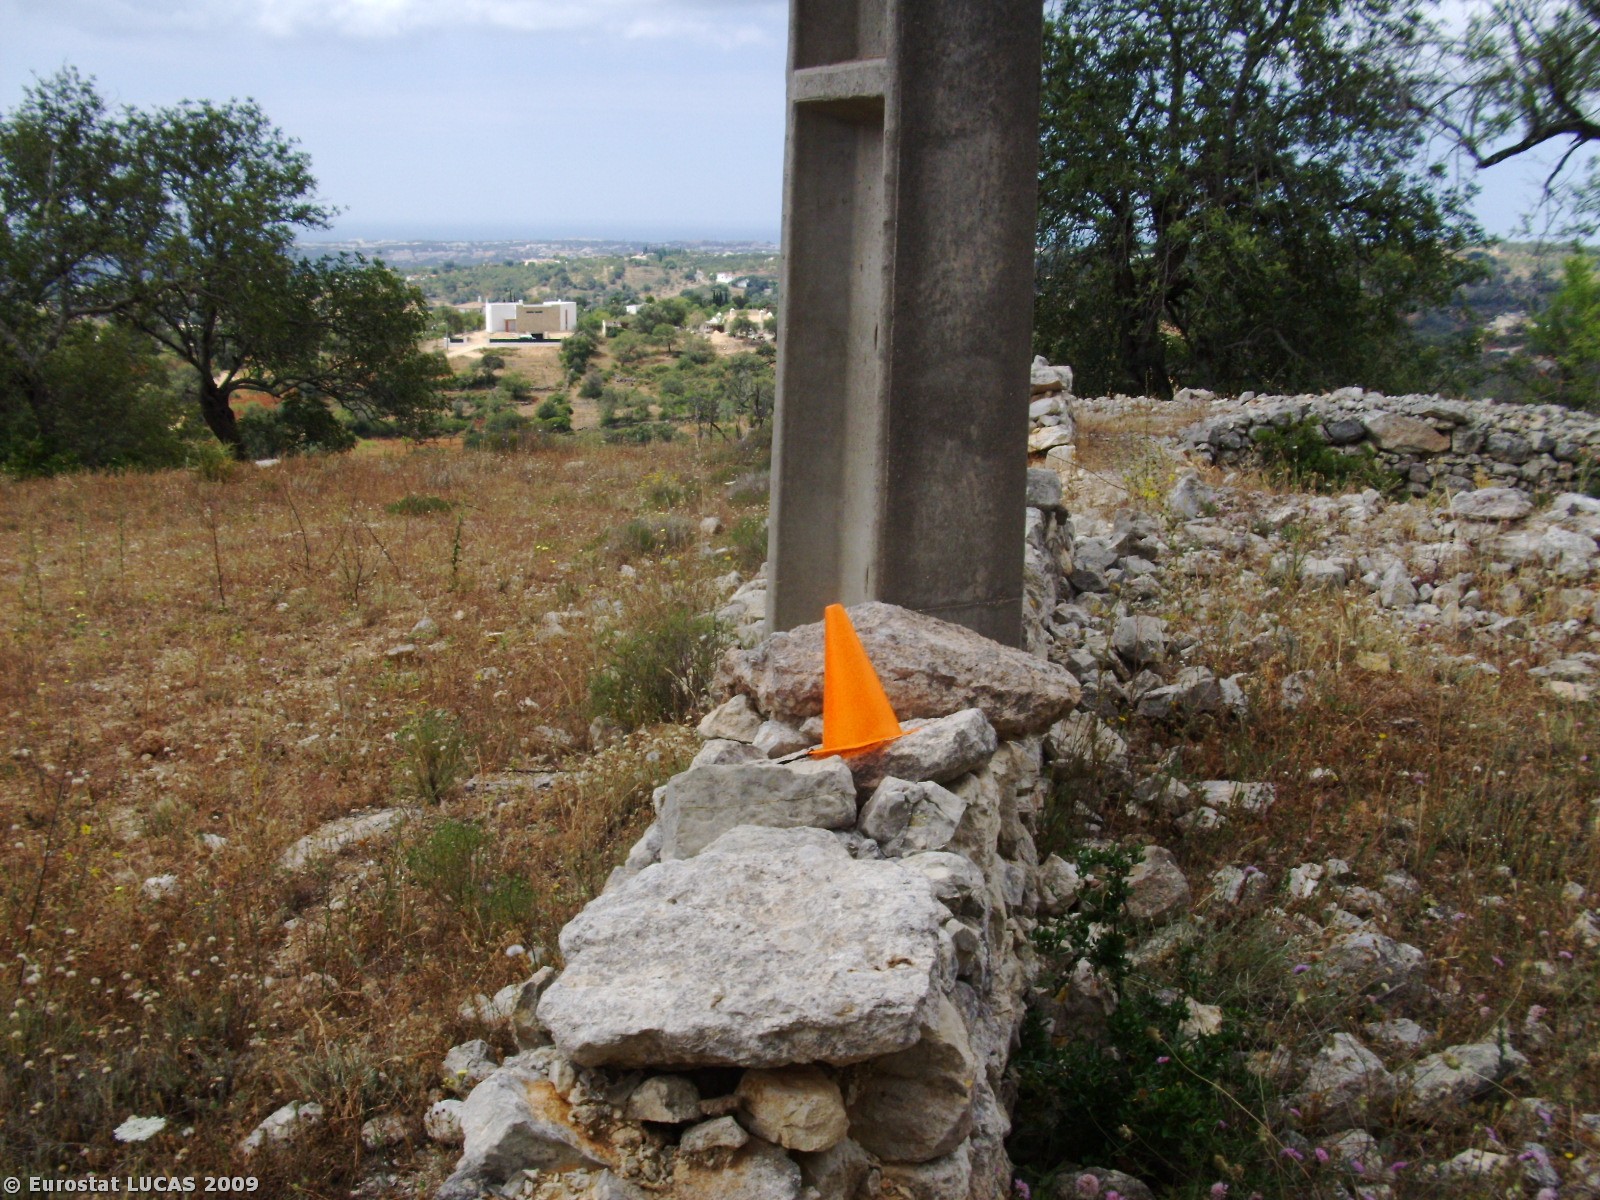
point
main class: Grassland
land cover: Spontaneously vegetated surfaces
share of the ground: 25 - 50 %
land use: Unused
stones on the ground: 25 - 50 %
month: May
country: PT
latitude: 37.1510
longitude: -8.1553
